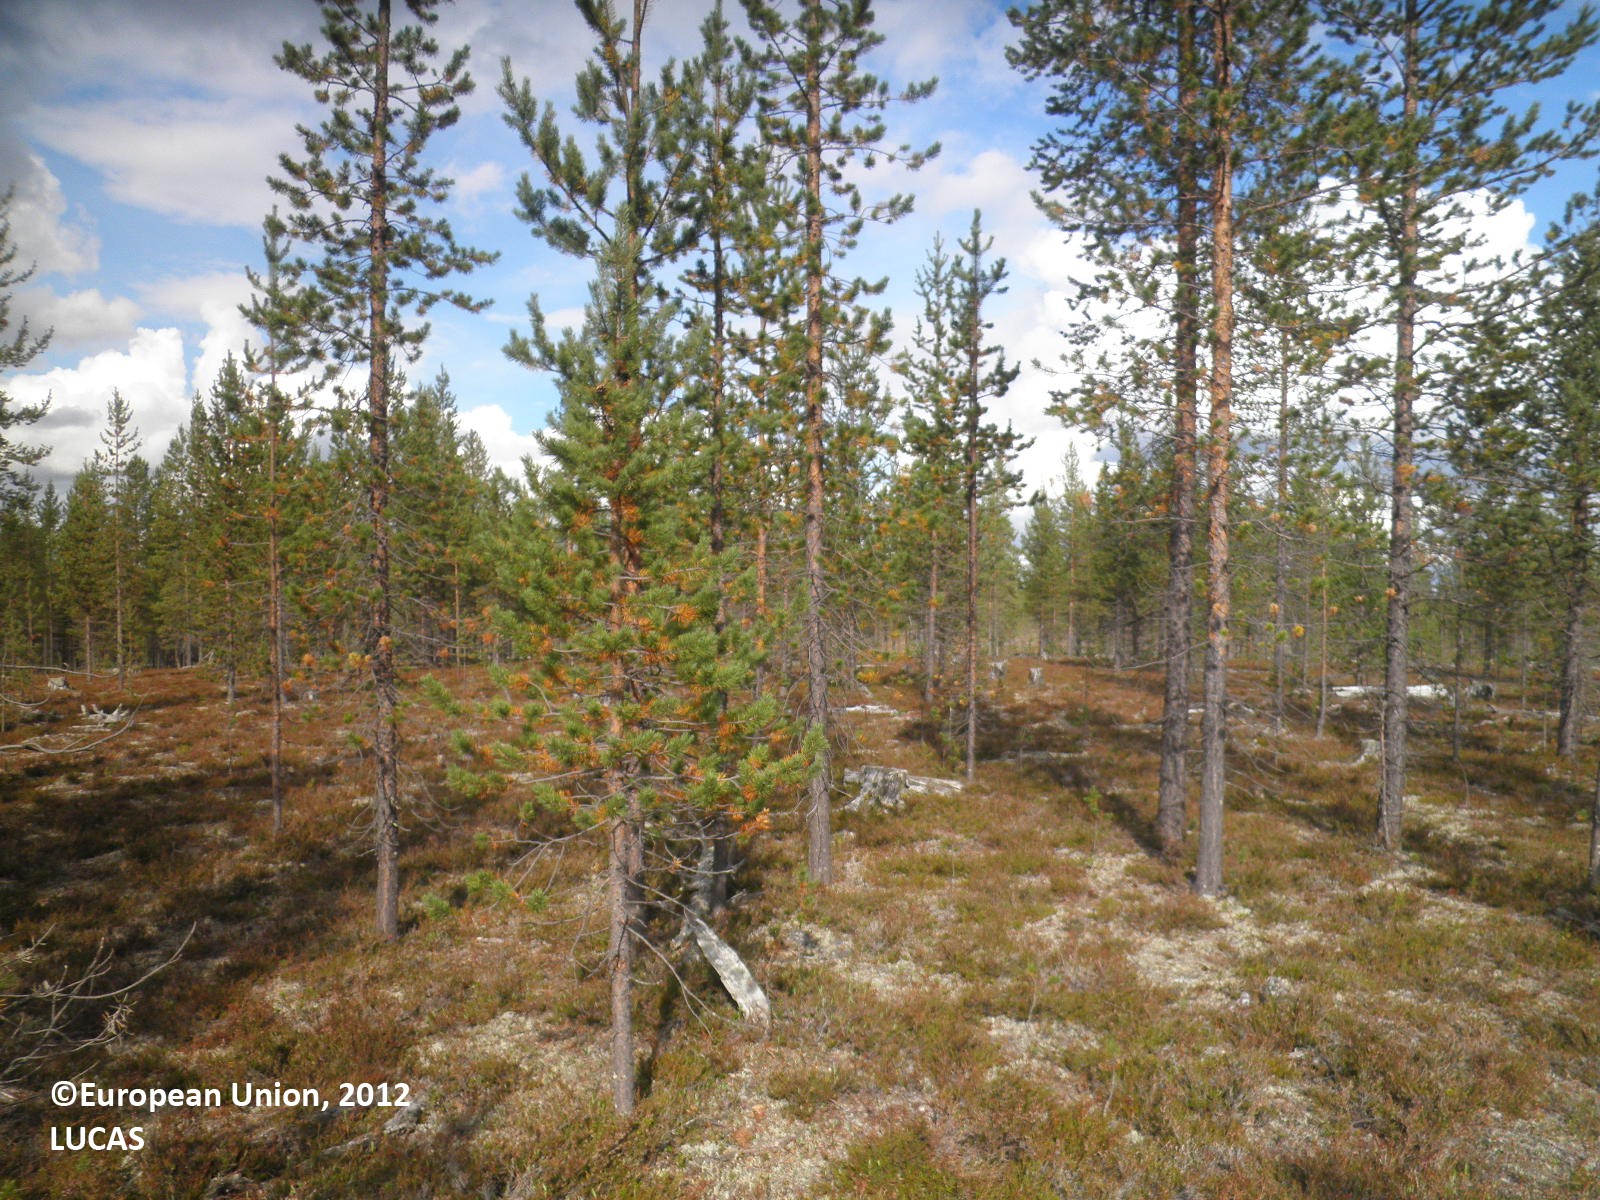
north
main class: Woodland
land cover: Pine dominated coniferous woodland
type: boreal forest
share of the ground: 25 - 50 %
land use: Forestry
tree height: > 5 m
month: August
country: FI
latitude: 67.9876
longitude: 28.2086
